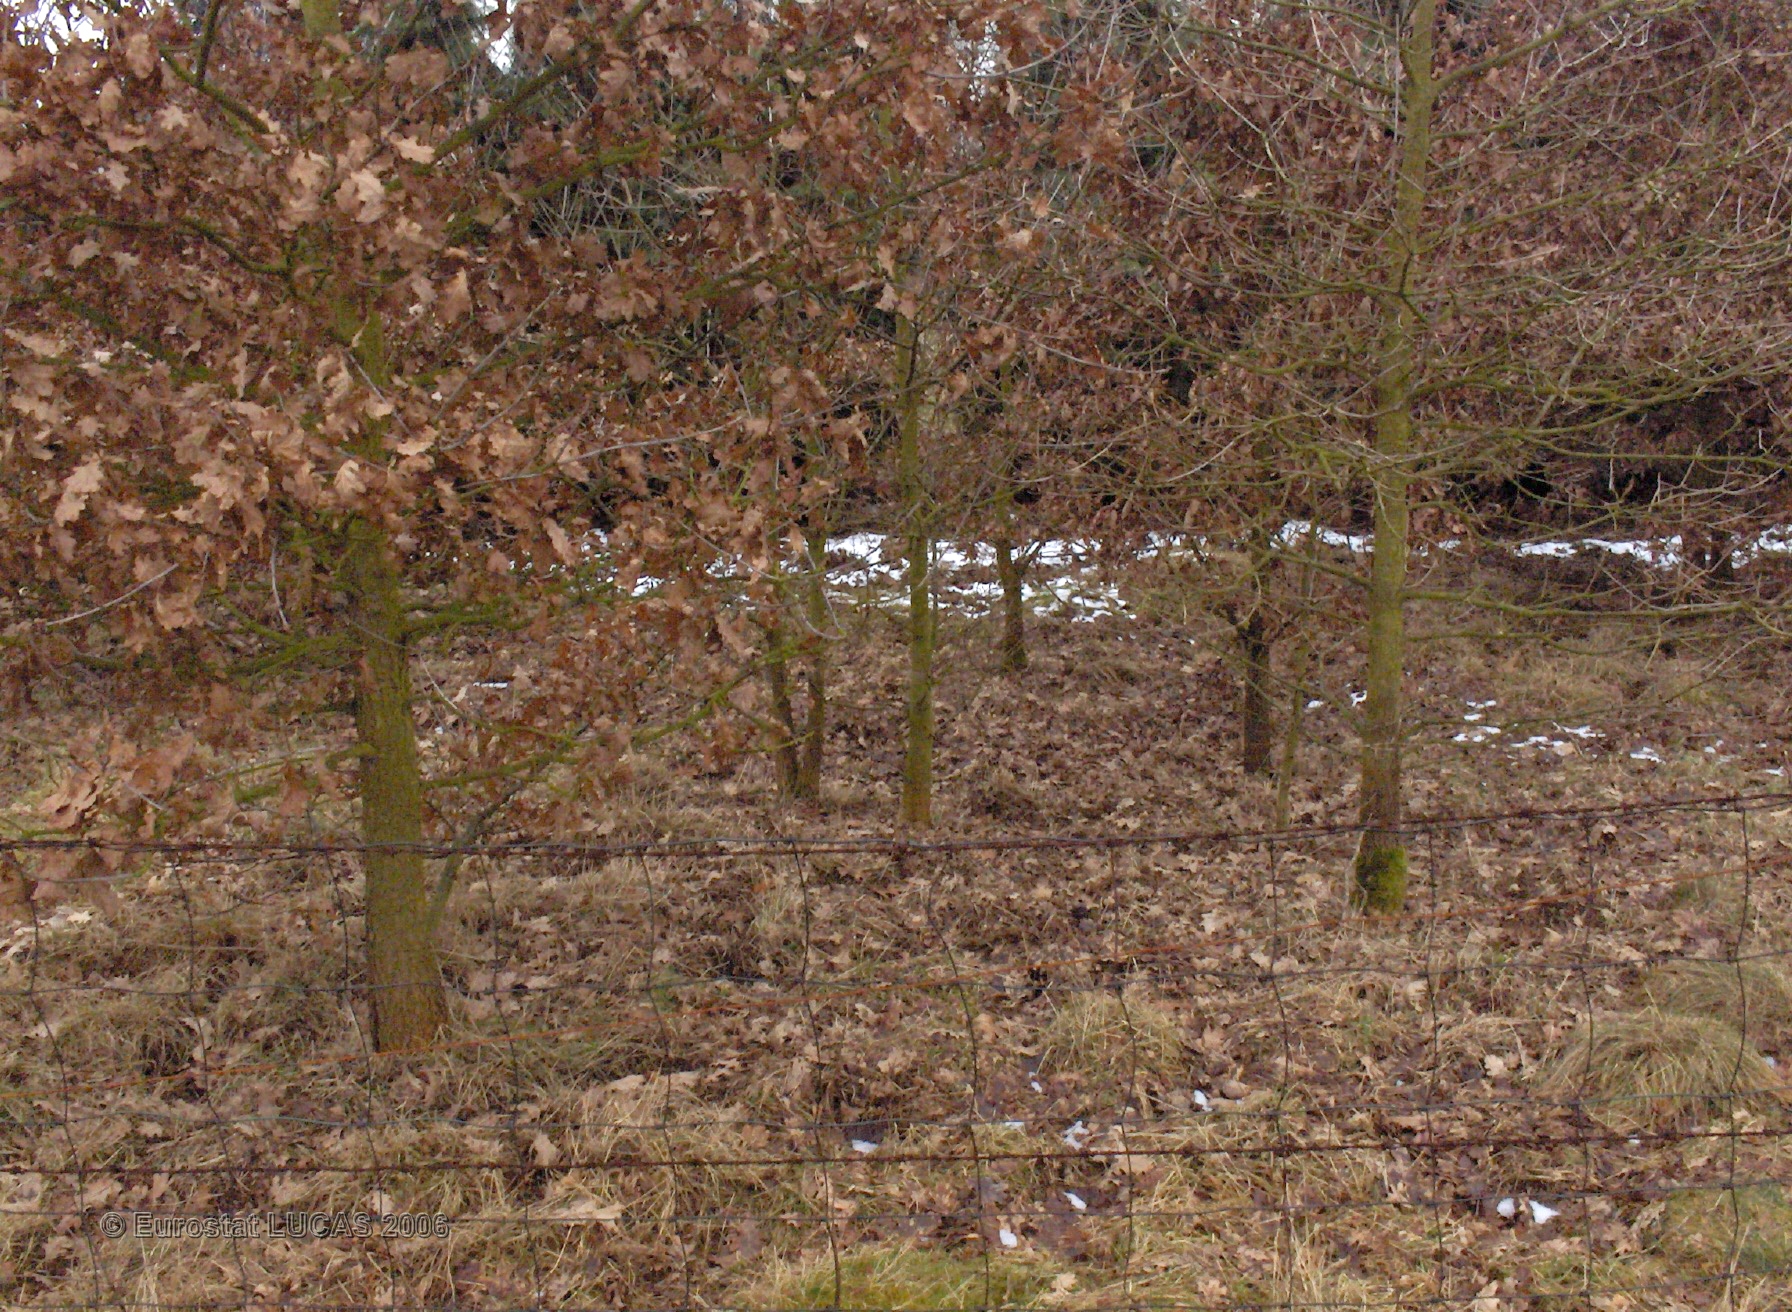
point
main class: Woodland
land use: Residential
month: March
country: BE
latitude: 51.0554
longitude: 5.1896
